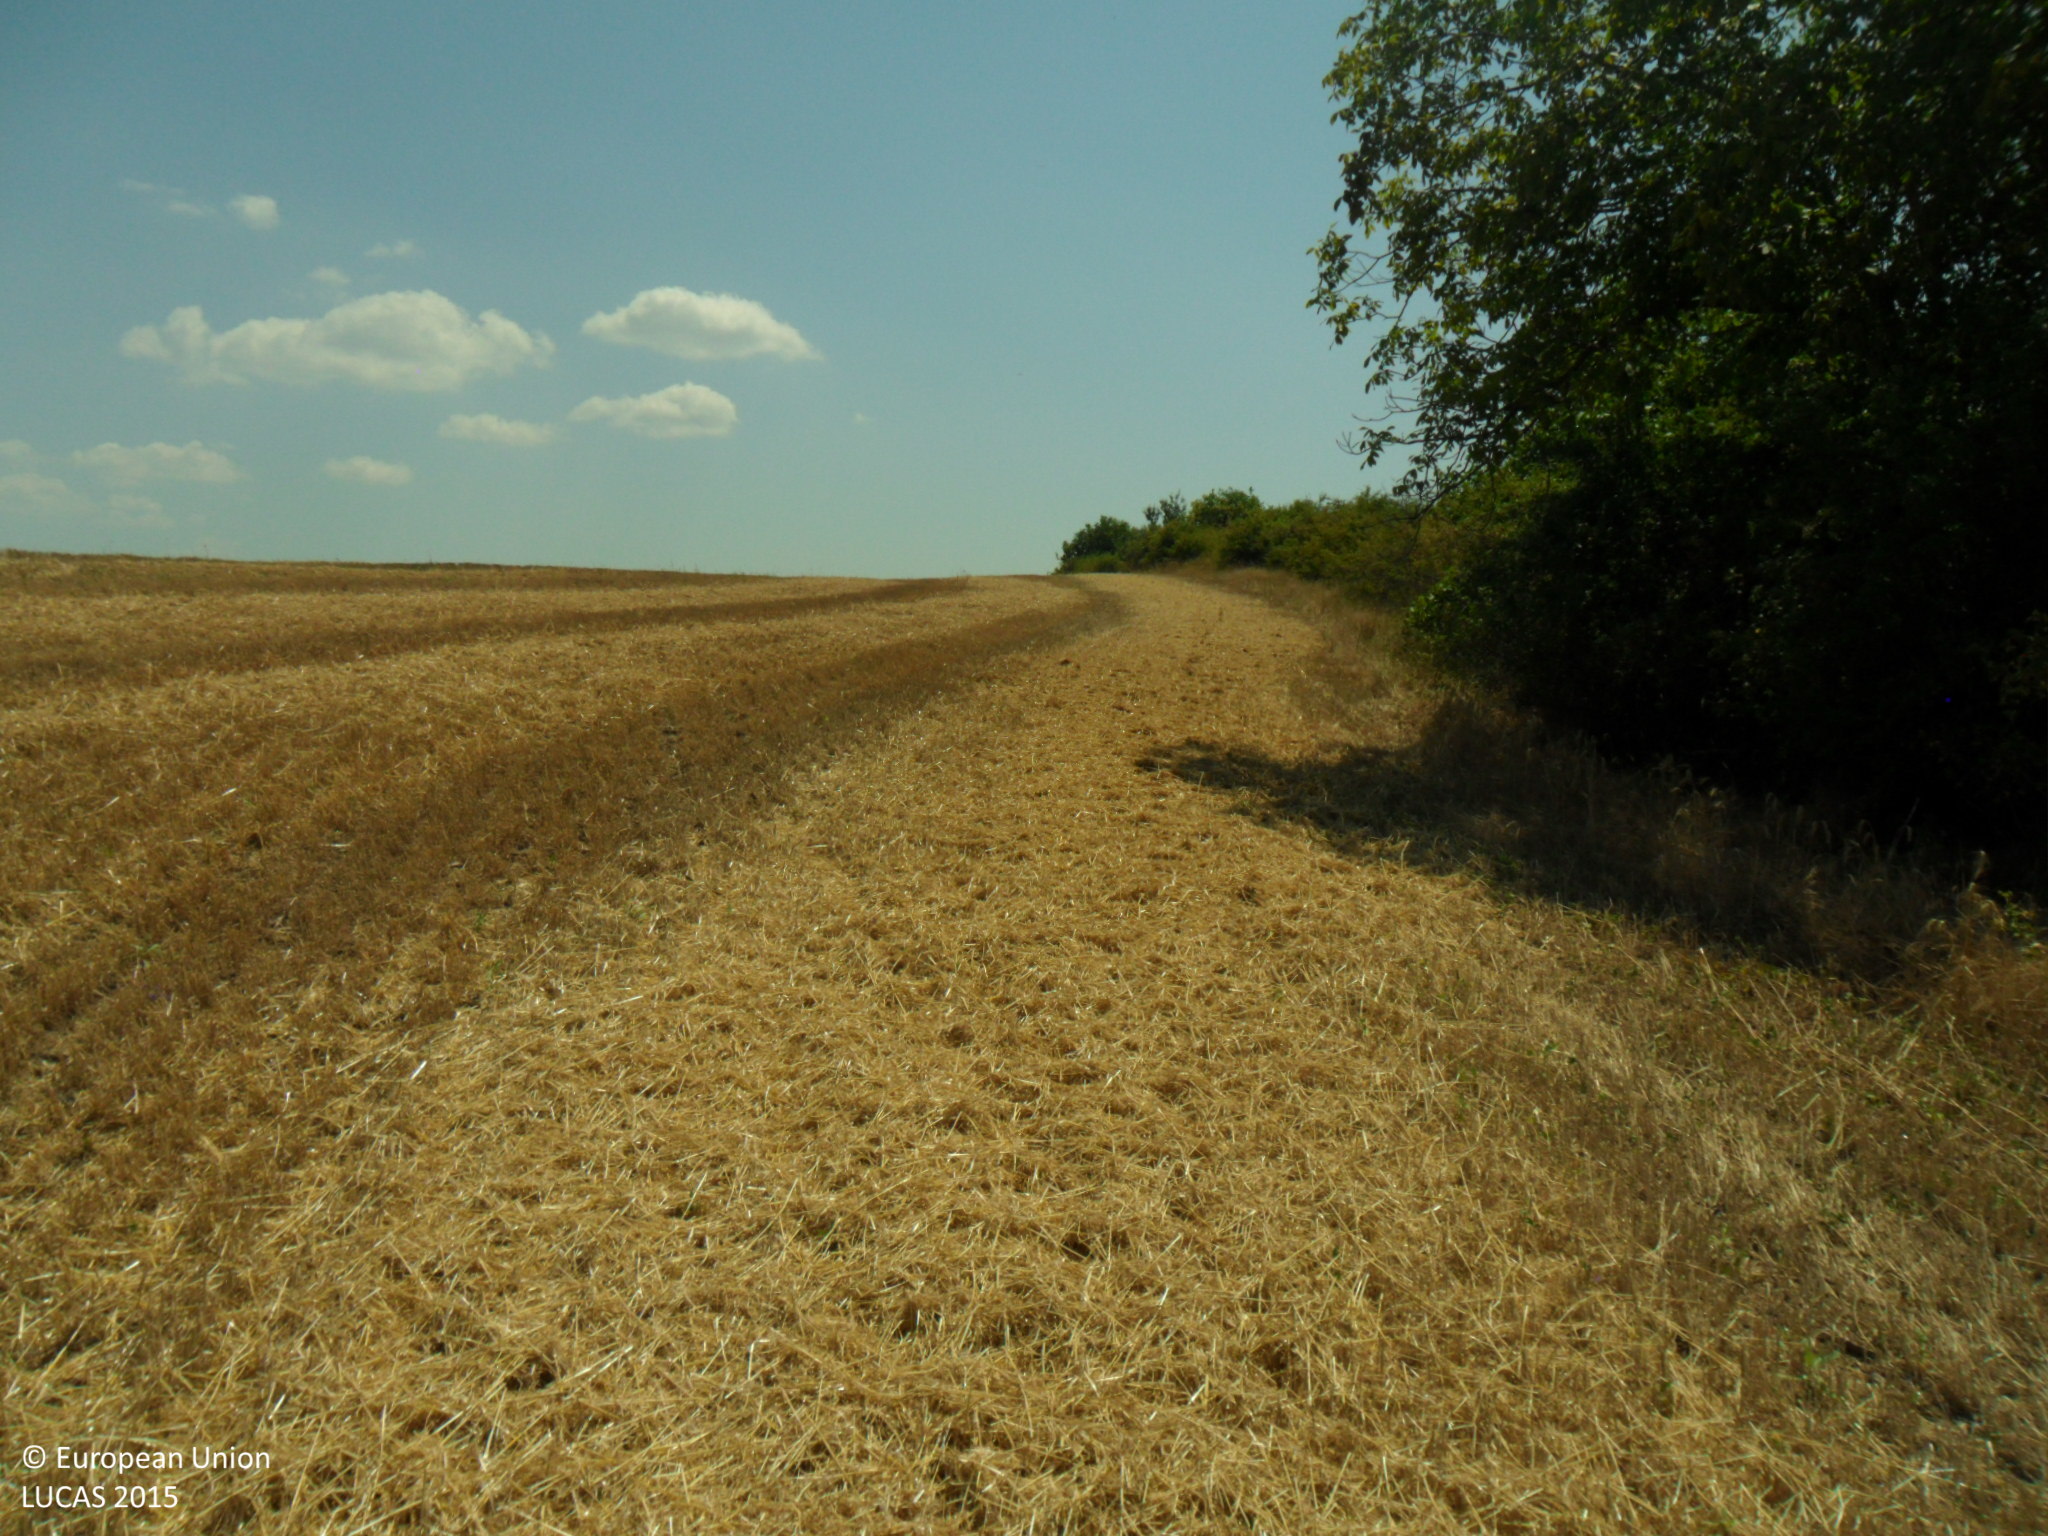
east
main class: Cropland
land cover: Common wheat
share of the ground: 50 - 75 %
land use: Agriculture (excluding fallow land and kitchen gardens)
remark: Harvested field
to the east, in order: Common wheat
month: July
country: BG
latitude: 43.4001
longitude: 26.6397
